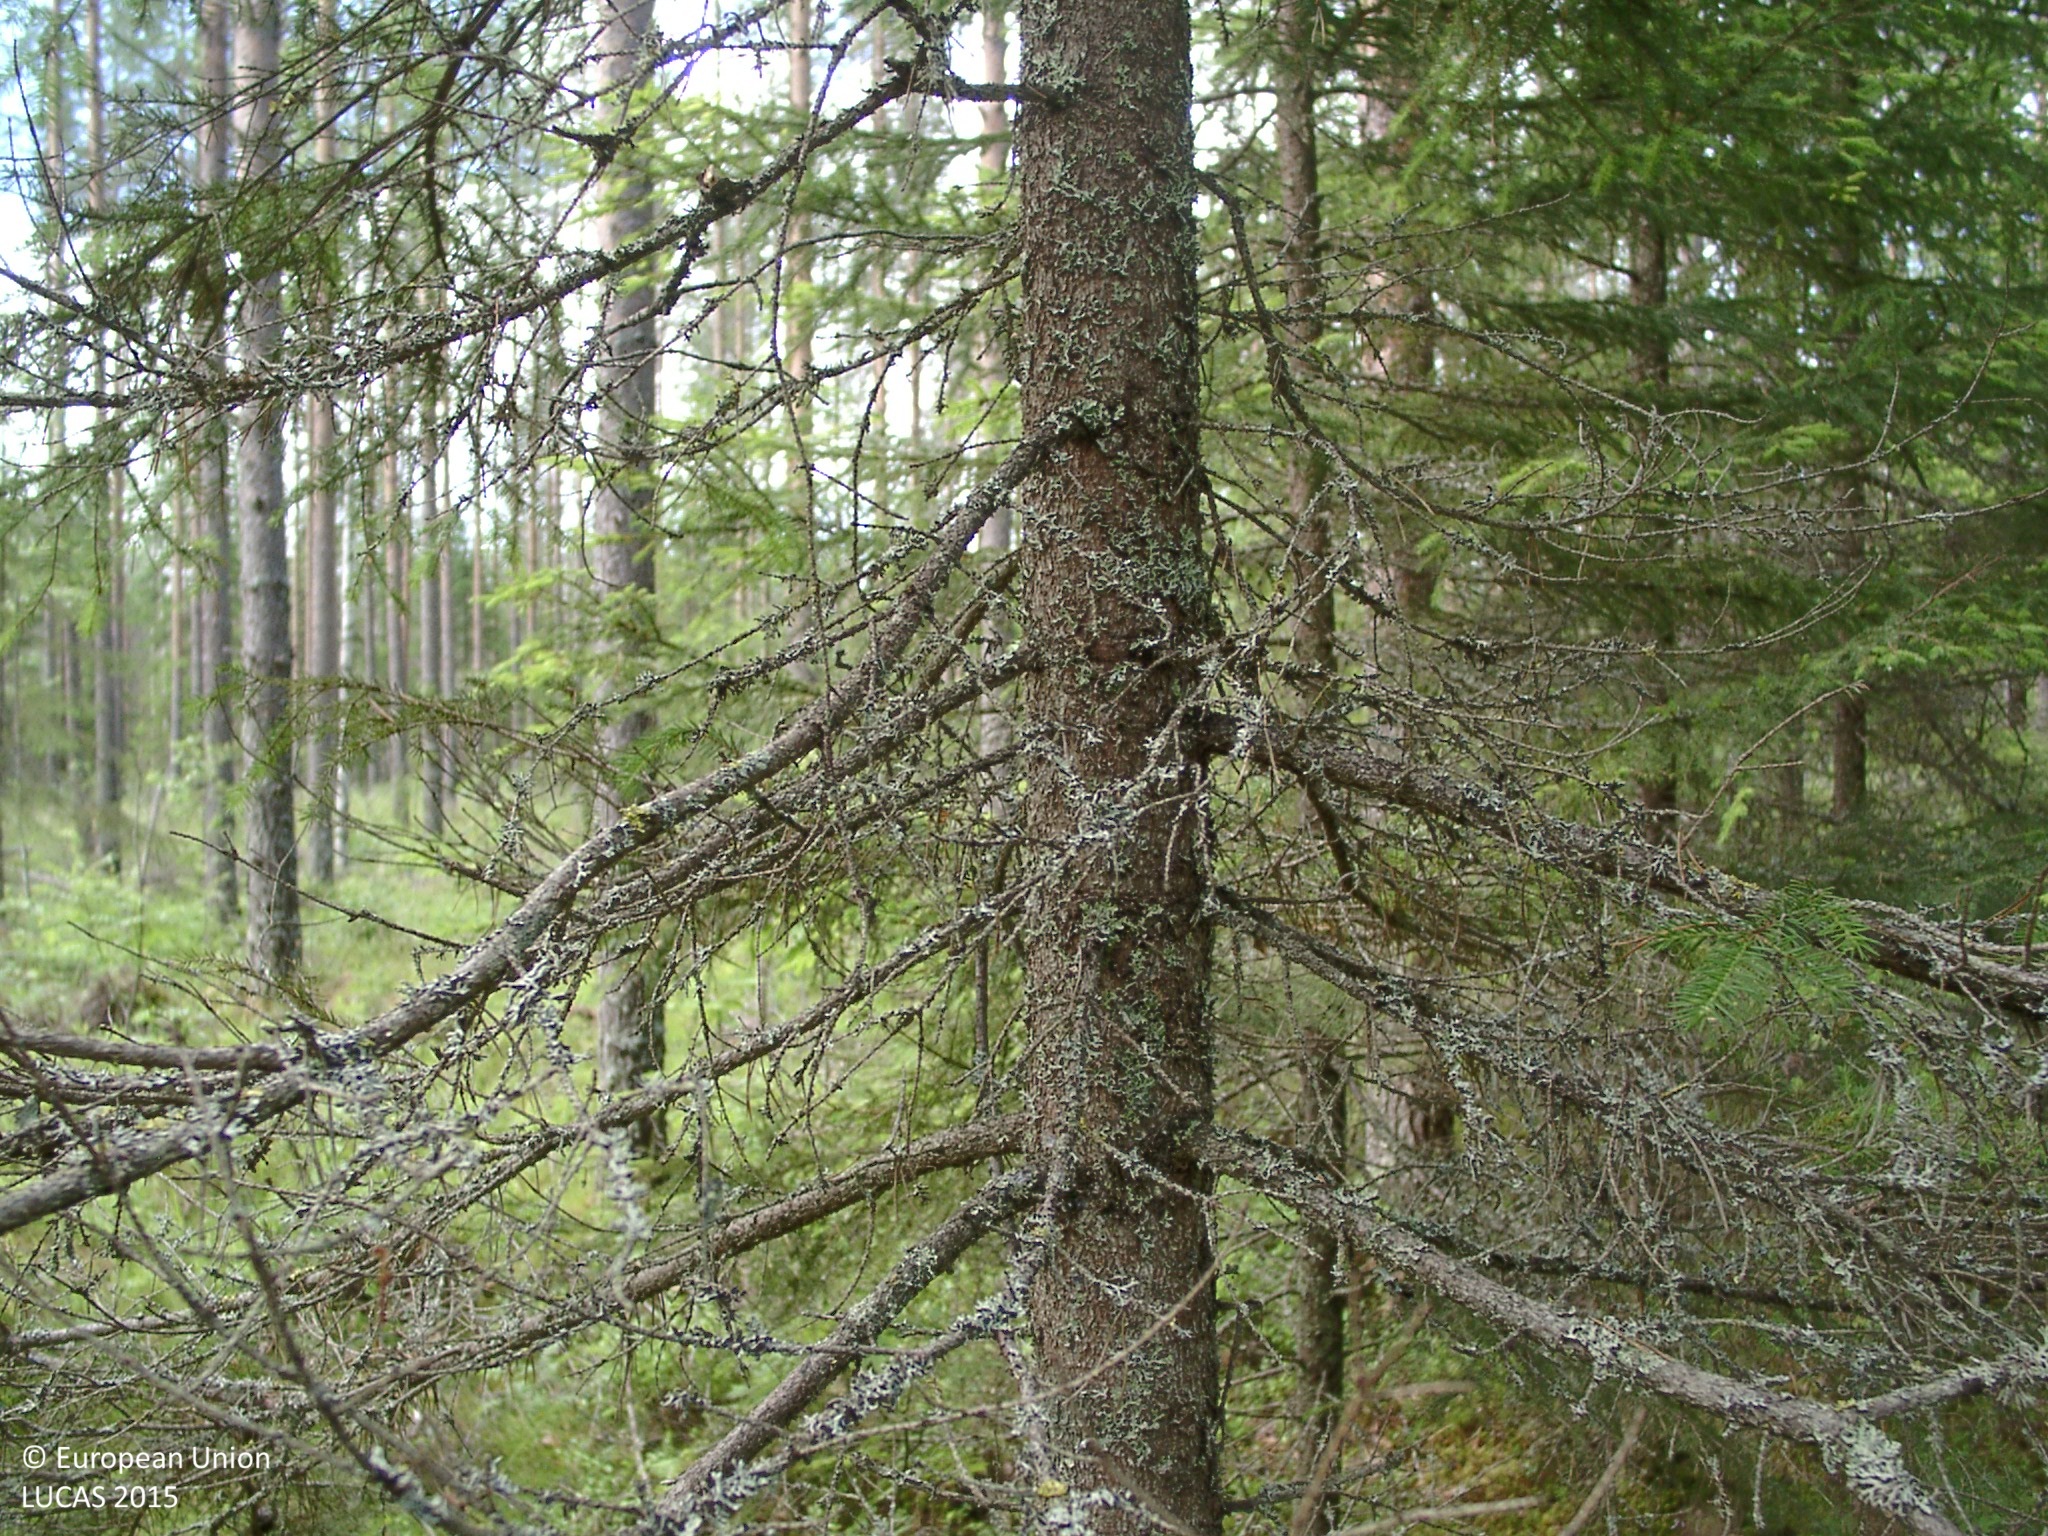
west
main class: Woodland
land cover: Other coniferous woodland
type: boreal forest
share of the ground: 50 - 75 %
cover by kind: coniferous forest trees 55 %, shrubs 20 %, herbaceous plants 10 %, lichens and mosses 10 %, broadleaved forest trees 5 %
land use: Forestry
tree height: > 5 m
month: July
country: FI
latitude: 62.1832
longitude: 25.0295
